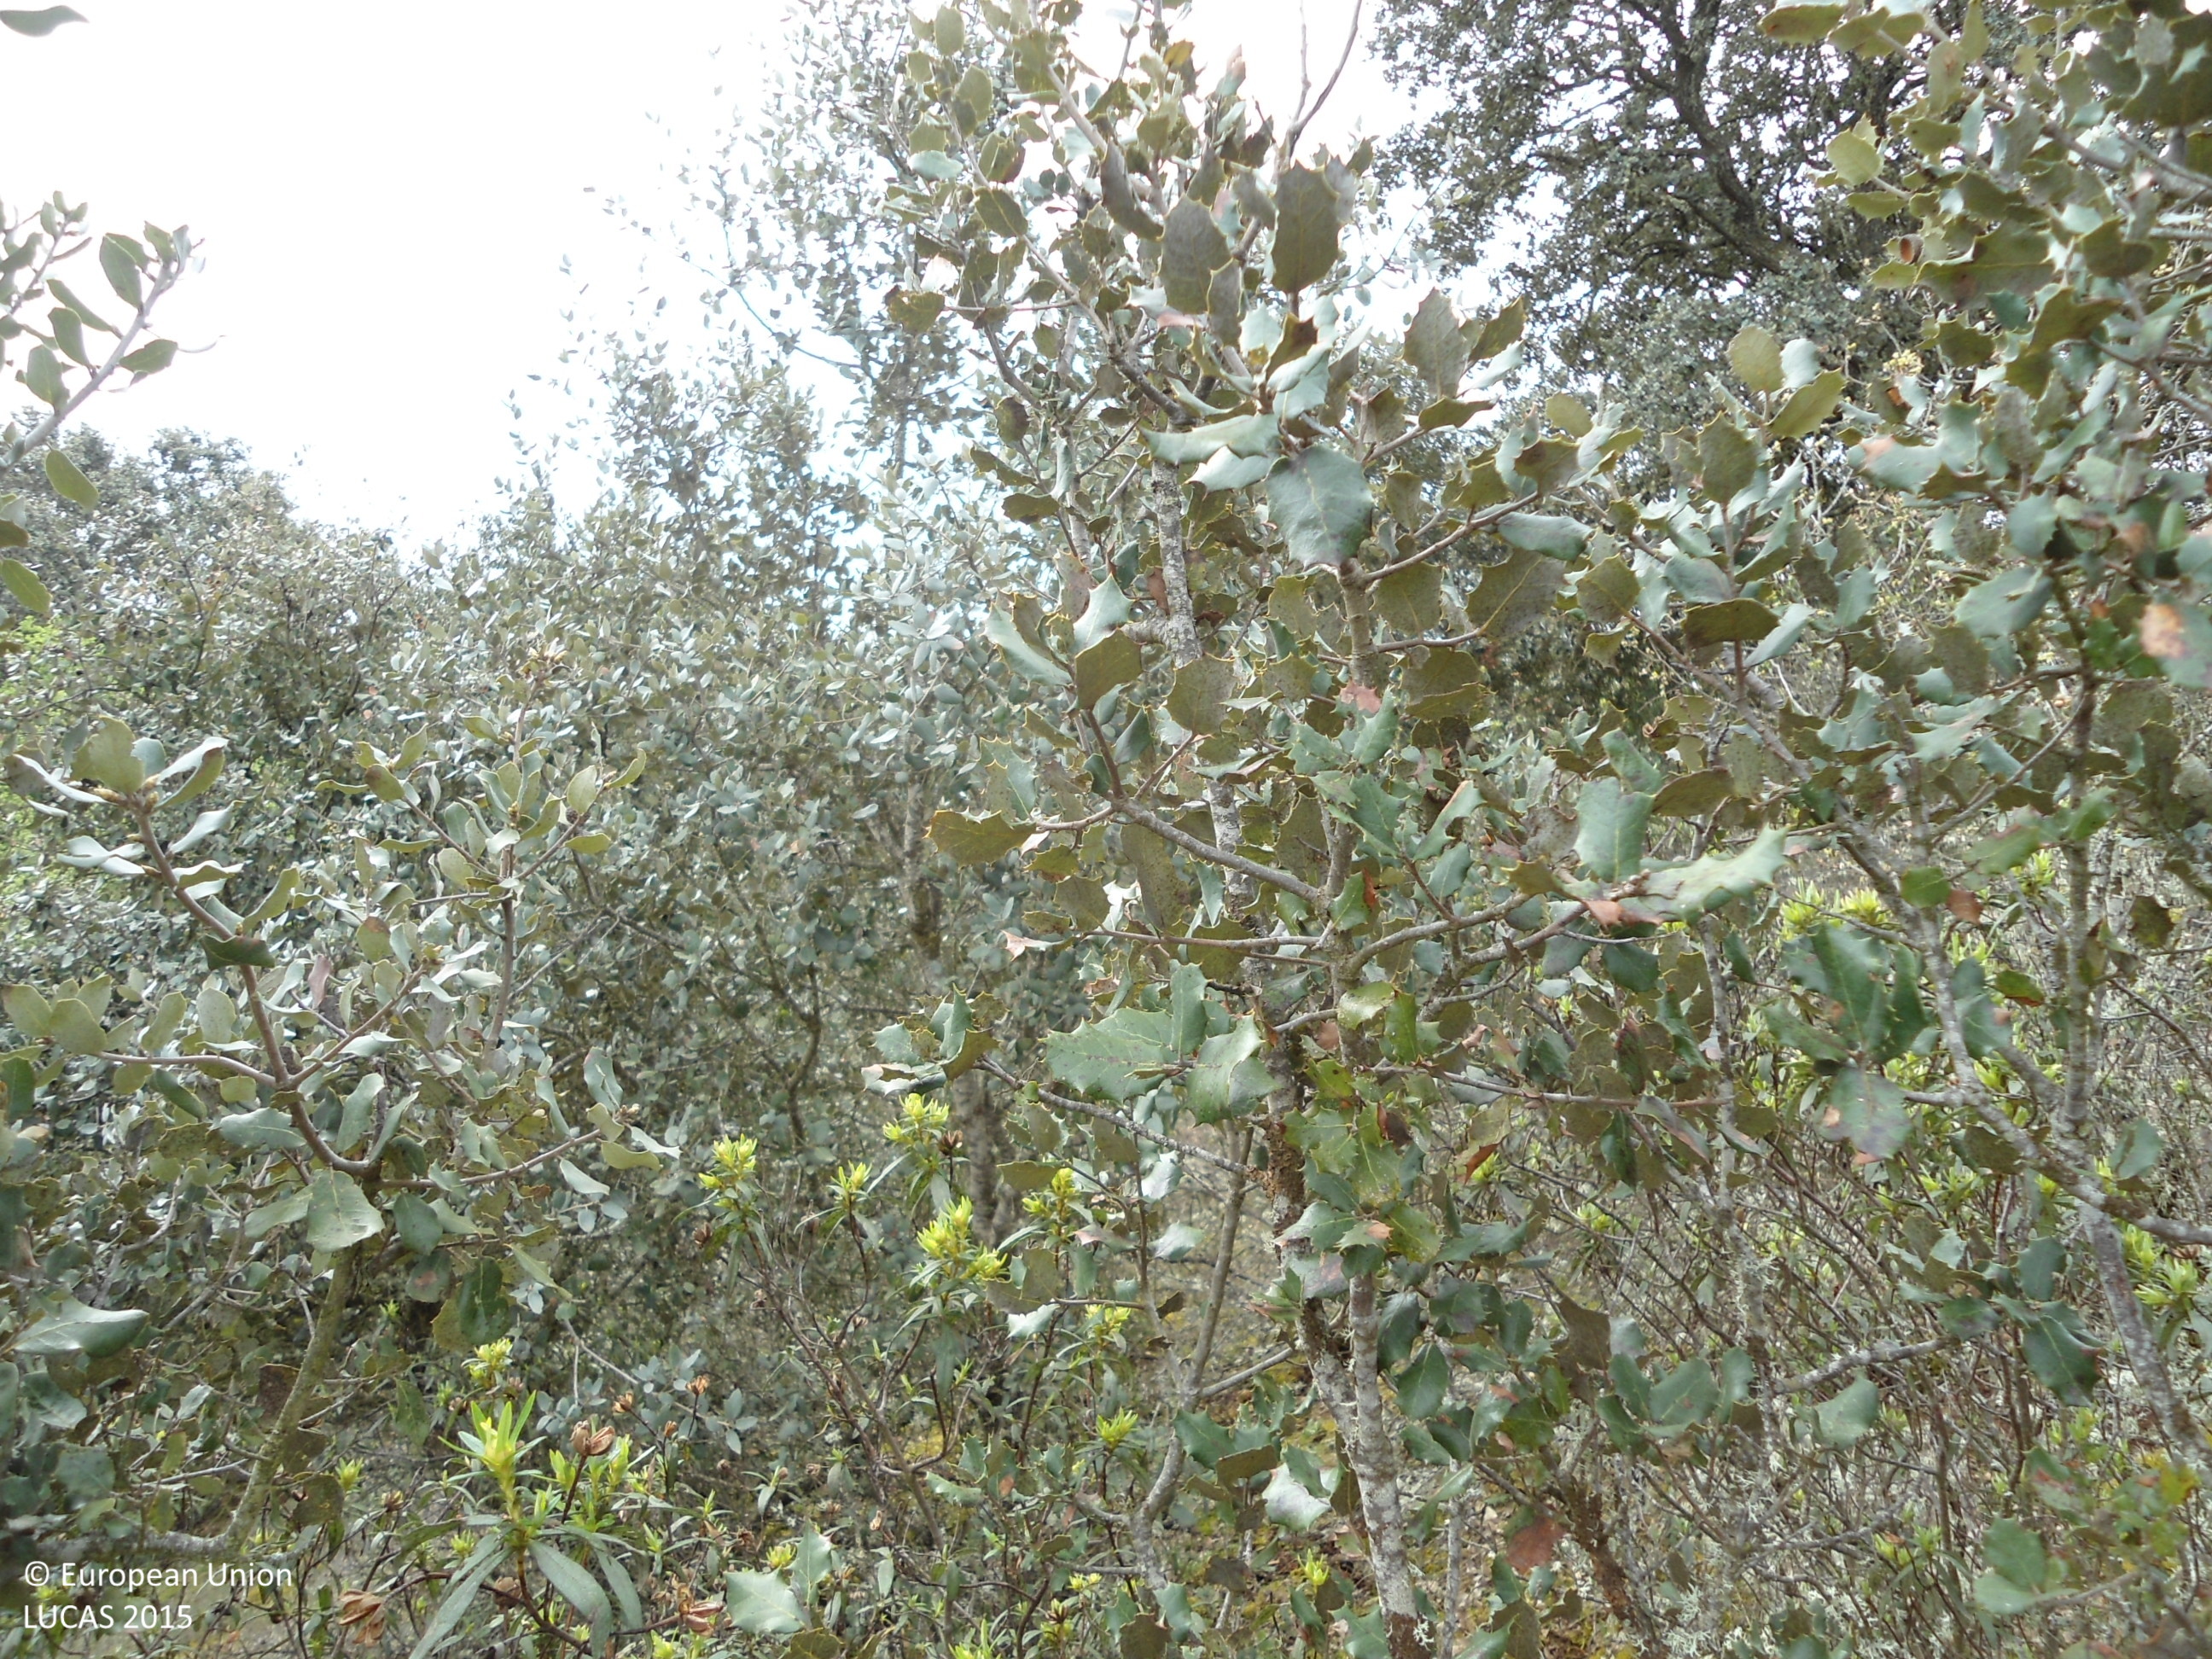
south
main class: Woodland
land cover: Broadleaved woodland
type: acidophilous oak and oak-birch forest
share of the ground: 50 - 75 %
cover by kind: broadleaved forest trees 80 %, shrubs 20 %
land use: Forestry
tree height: < 5 m
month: April
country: ES
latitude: 41.5357
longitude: -5.8997
